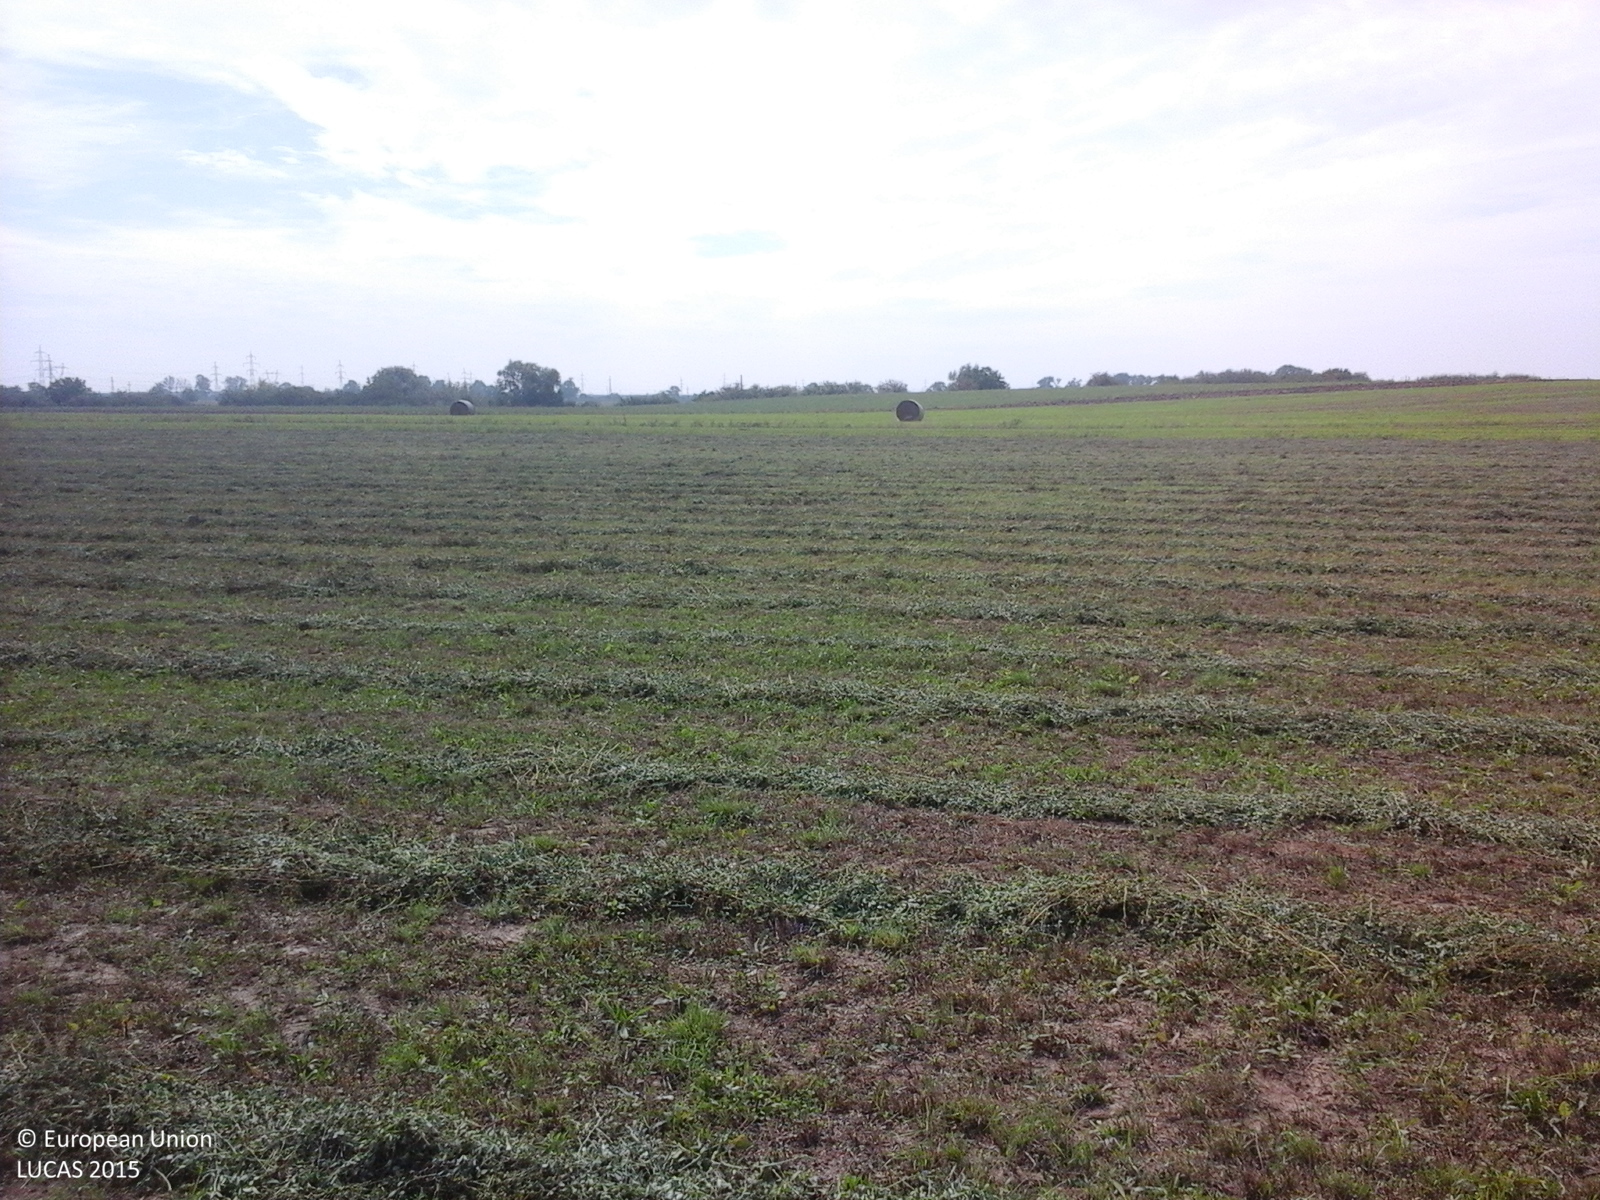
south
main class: Cropland
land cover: Lucerne
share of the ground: 50 - 75 %
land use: Agriculture (excluding fallow land and kitchen gardens)
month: August
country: RO
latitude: 46.1615
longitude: 21.3657
